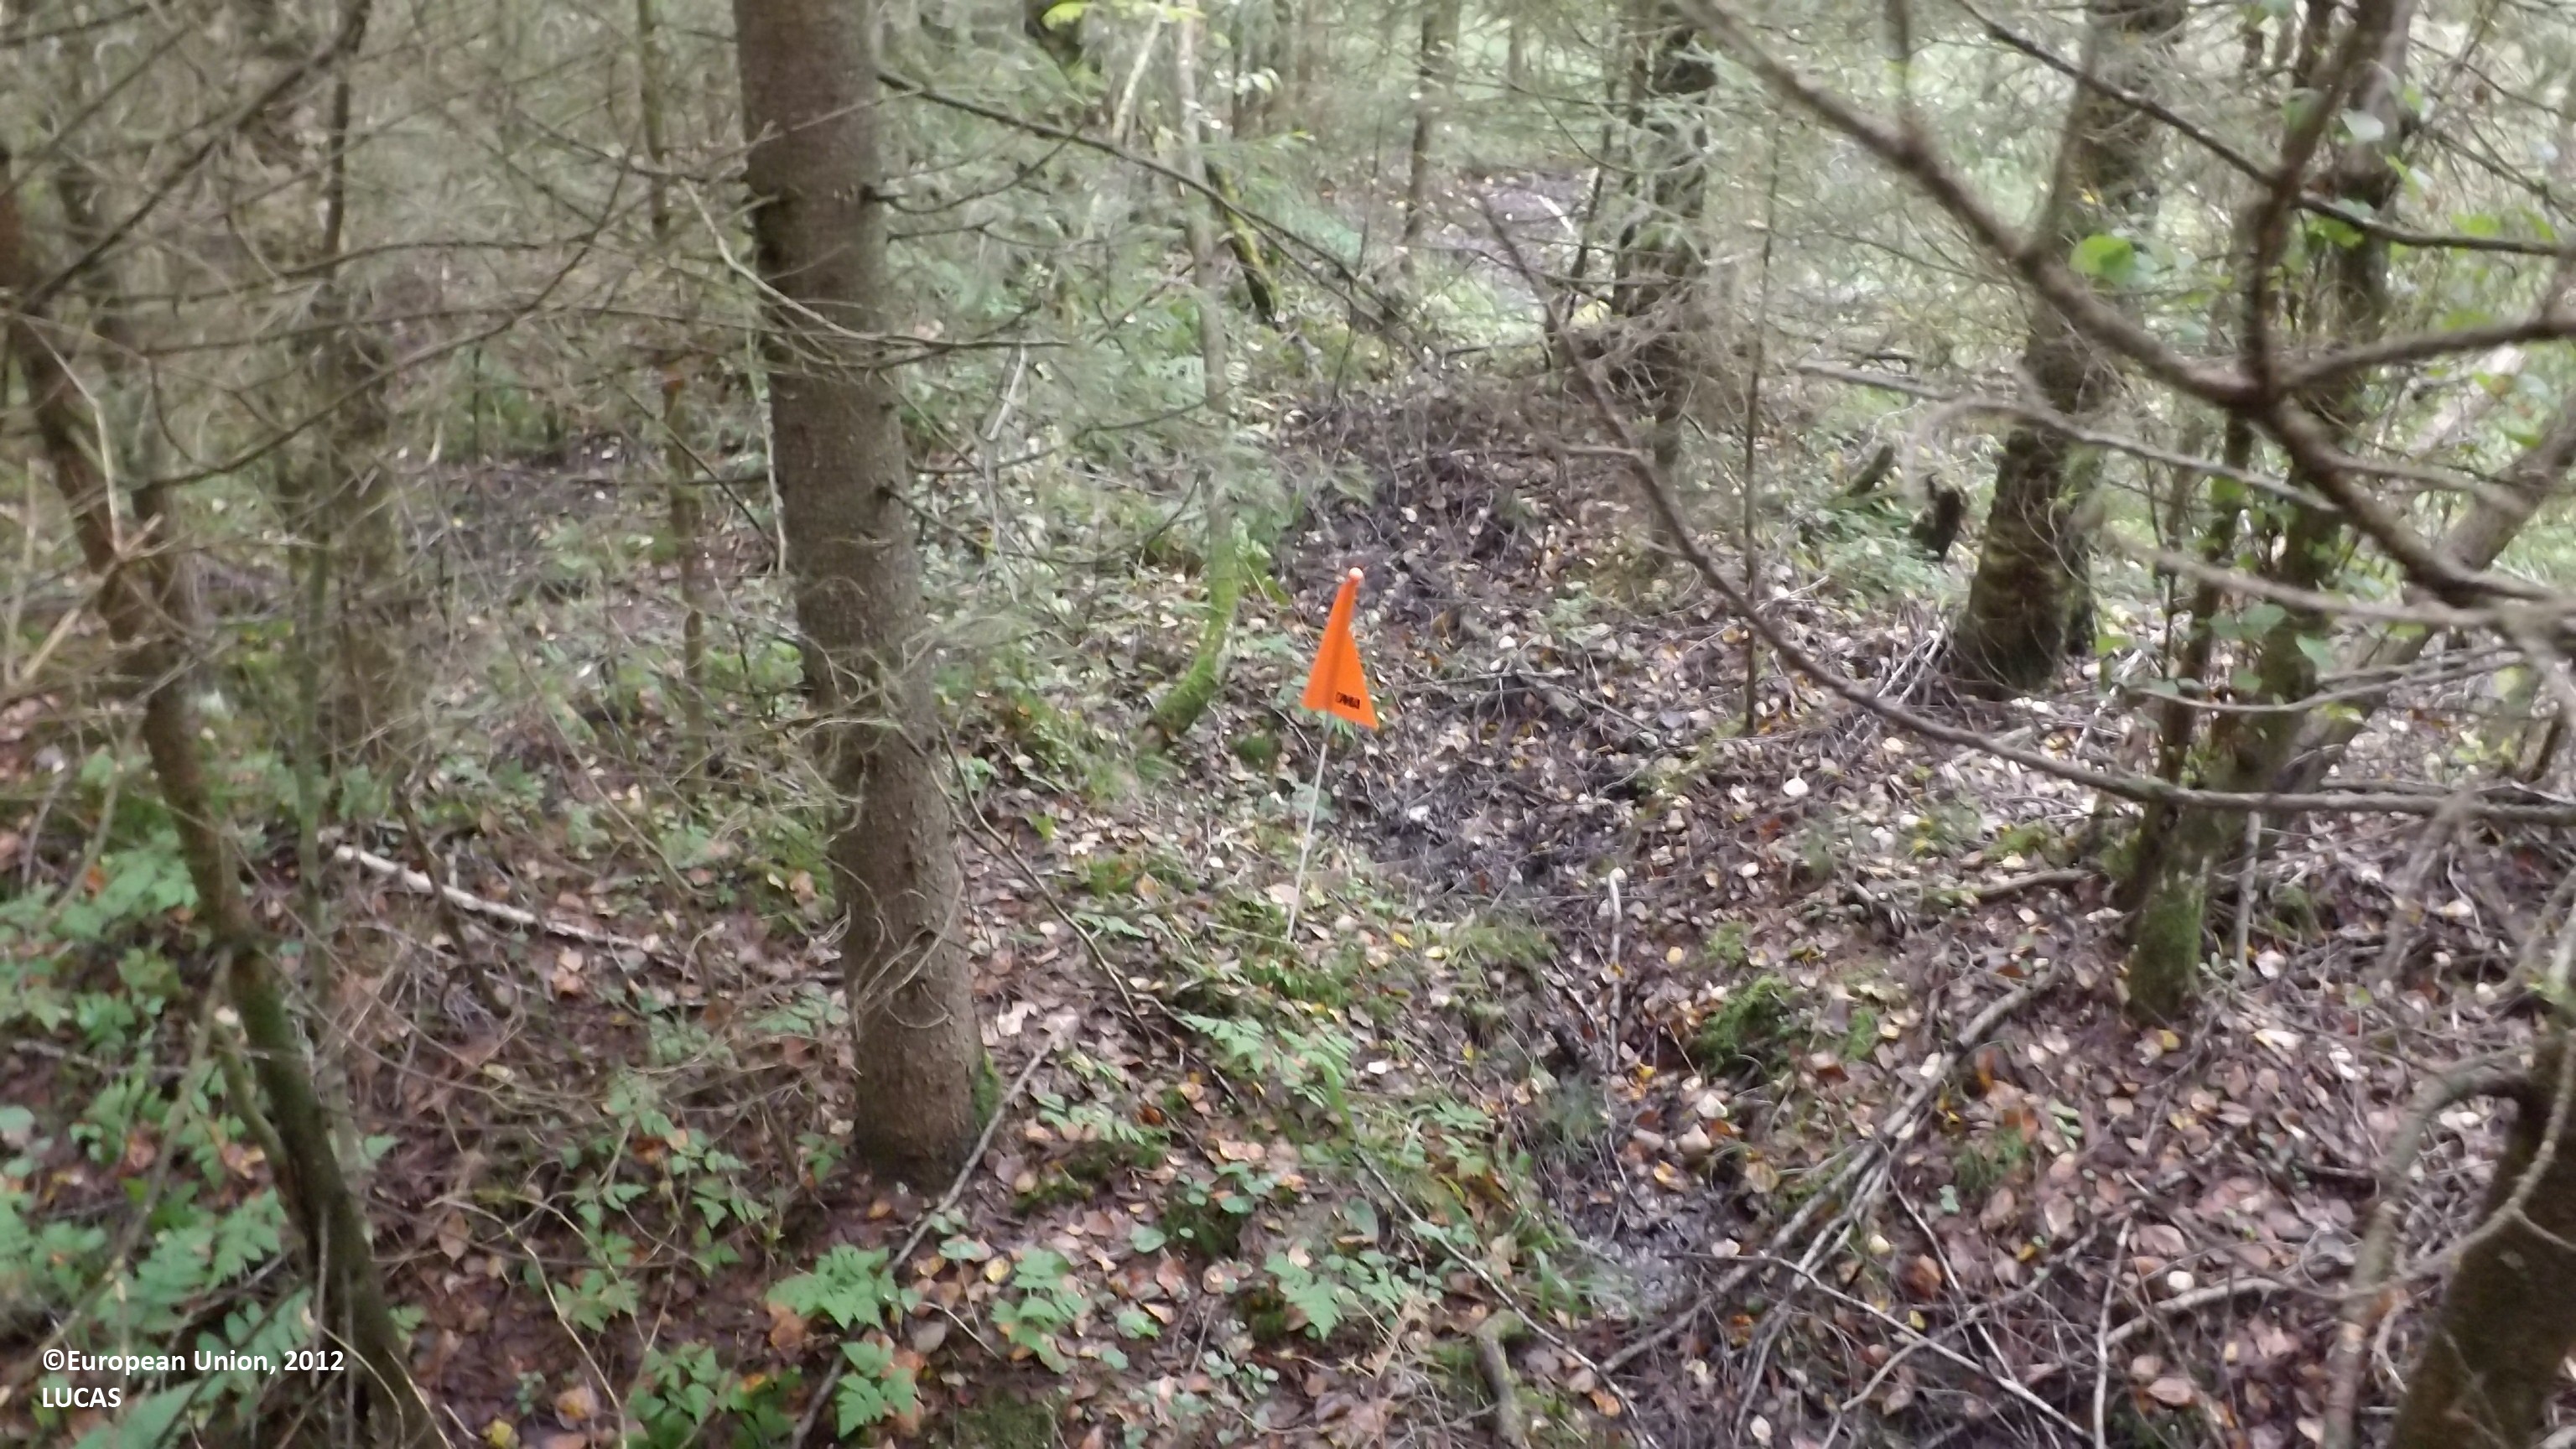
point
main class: Woodland
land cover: Spruce dominated mixed woodland
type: boreal forest
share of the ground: > 75 %
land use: Forestry
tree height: > 5 m
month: August
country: FI
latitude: 63.8437
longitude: 23.4156
